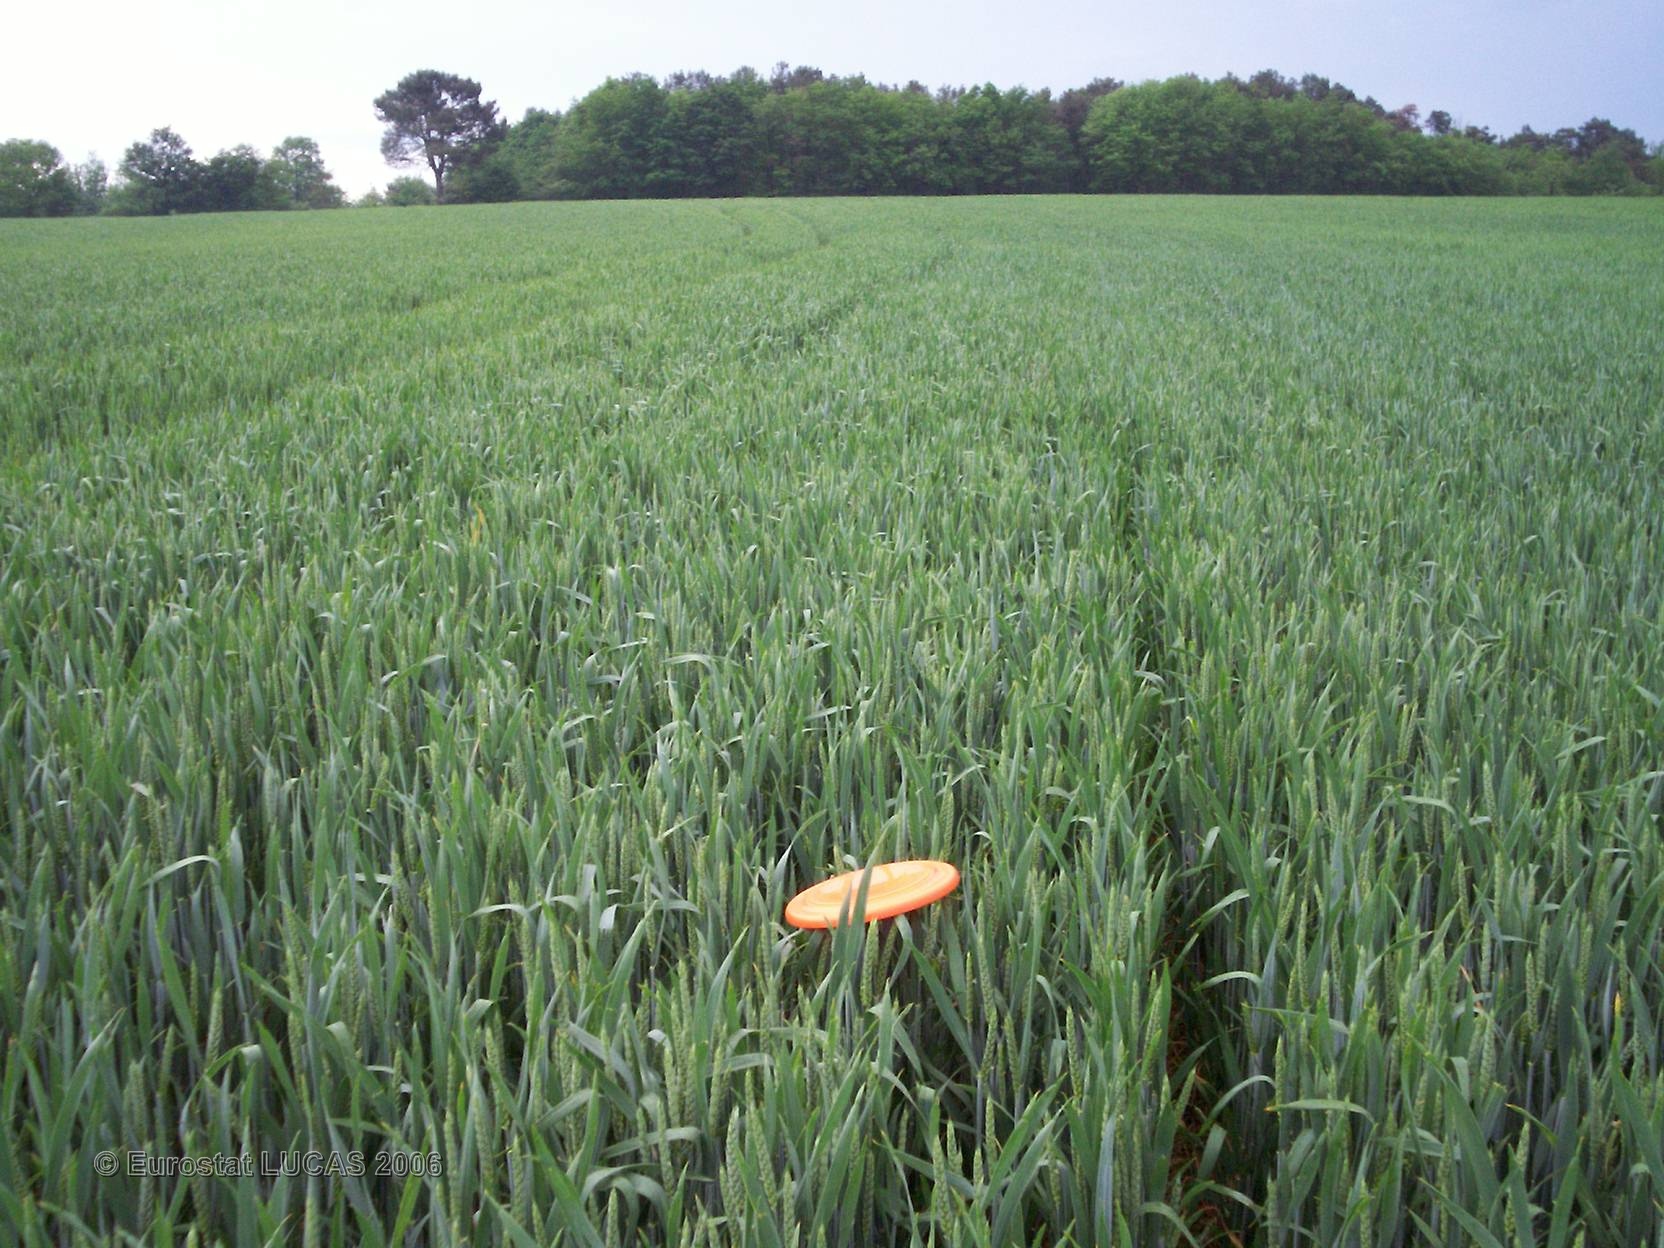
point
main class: Cropland
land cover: Common wheat
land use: Agriculture (excluding fallow land and kitchen gardens)
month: May
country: FR
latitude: 46.8410
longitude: 1.0031
